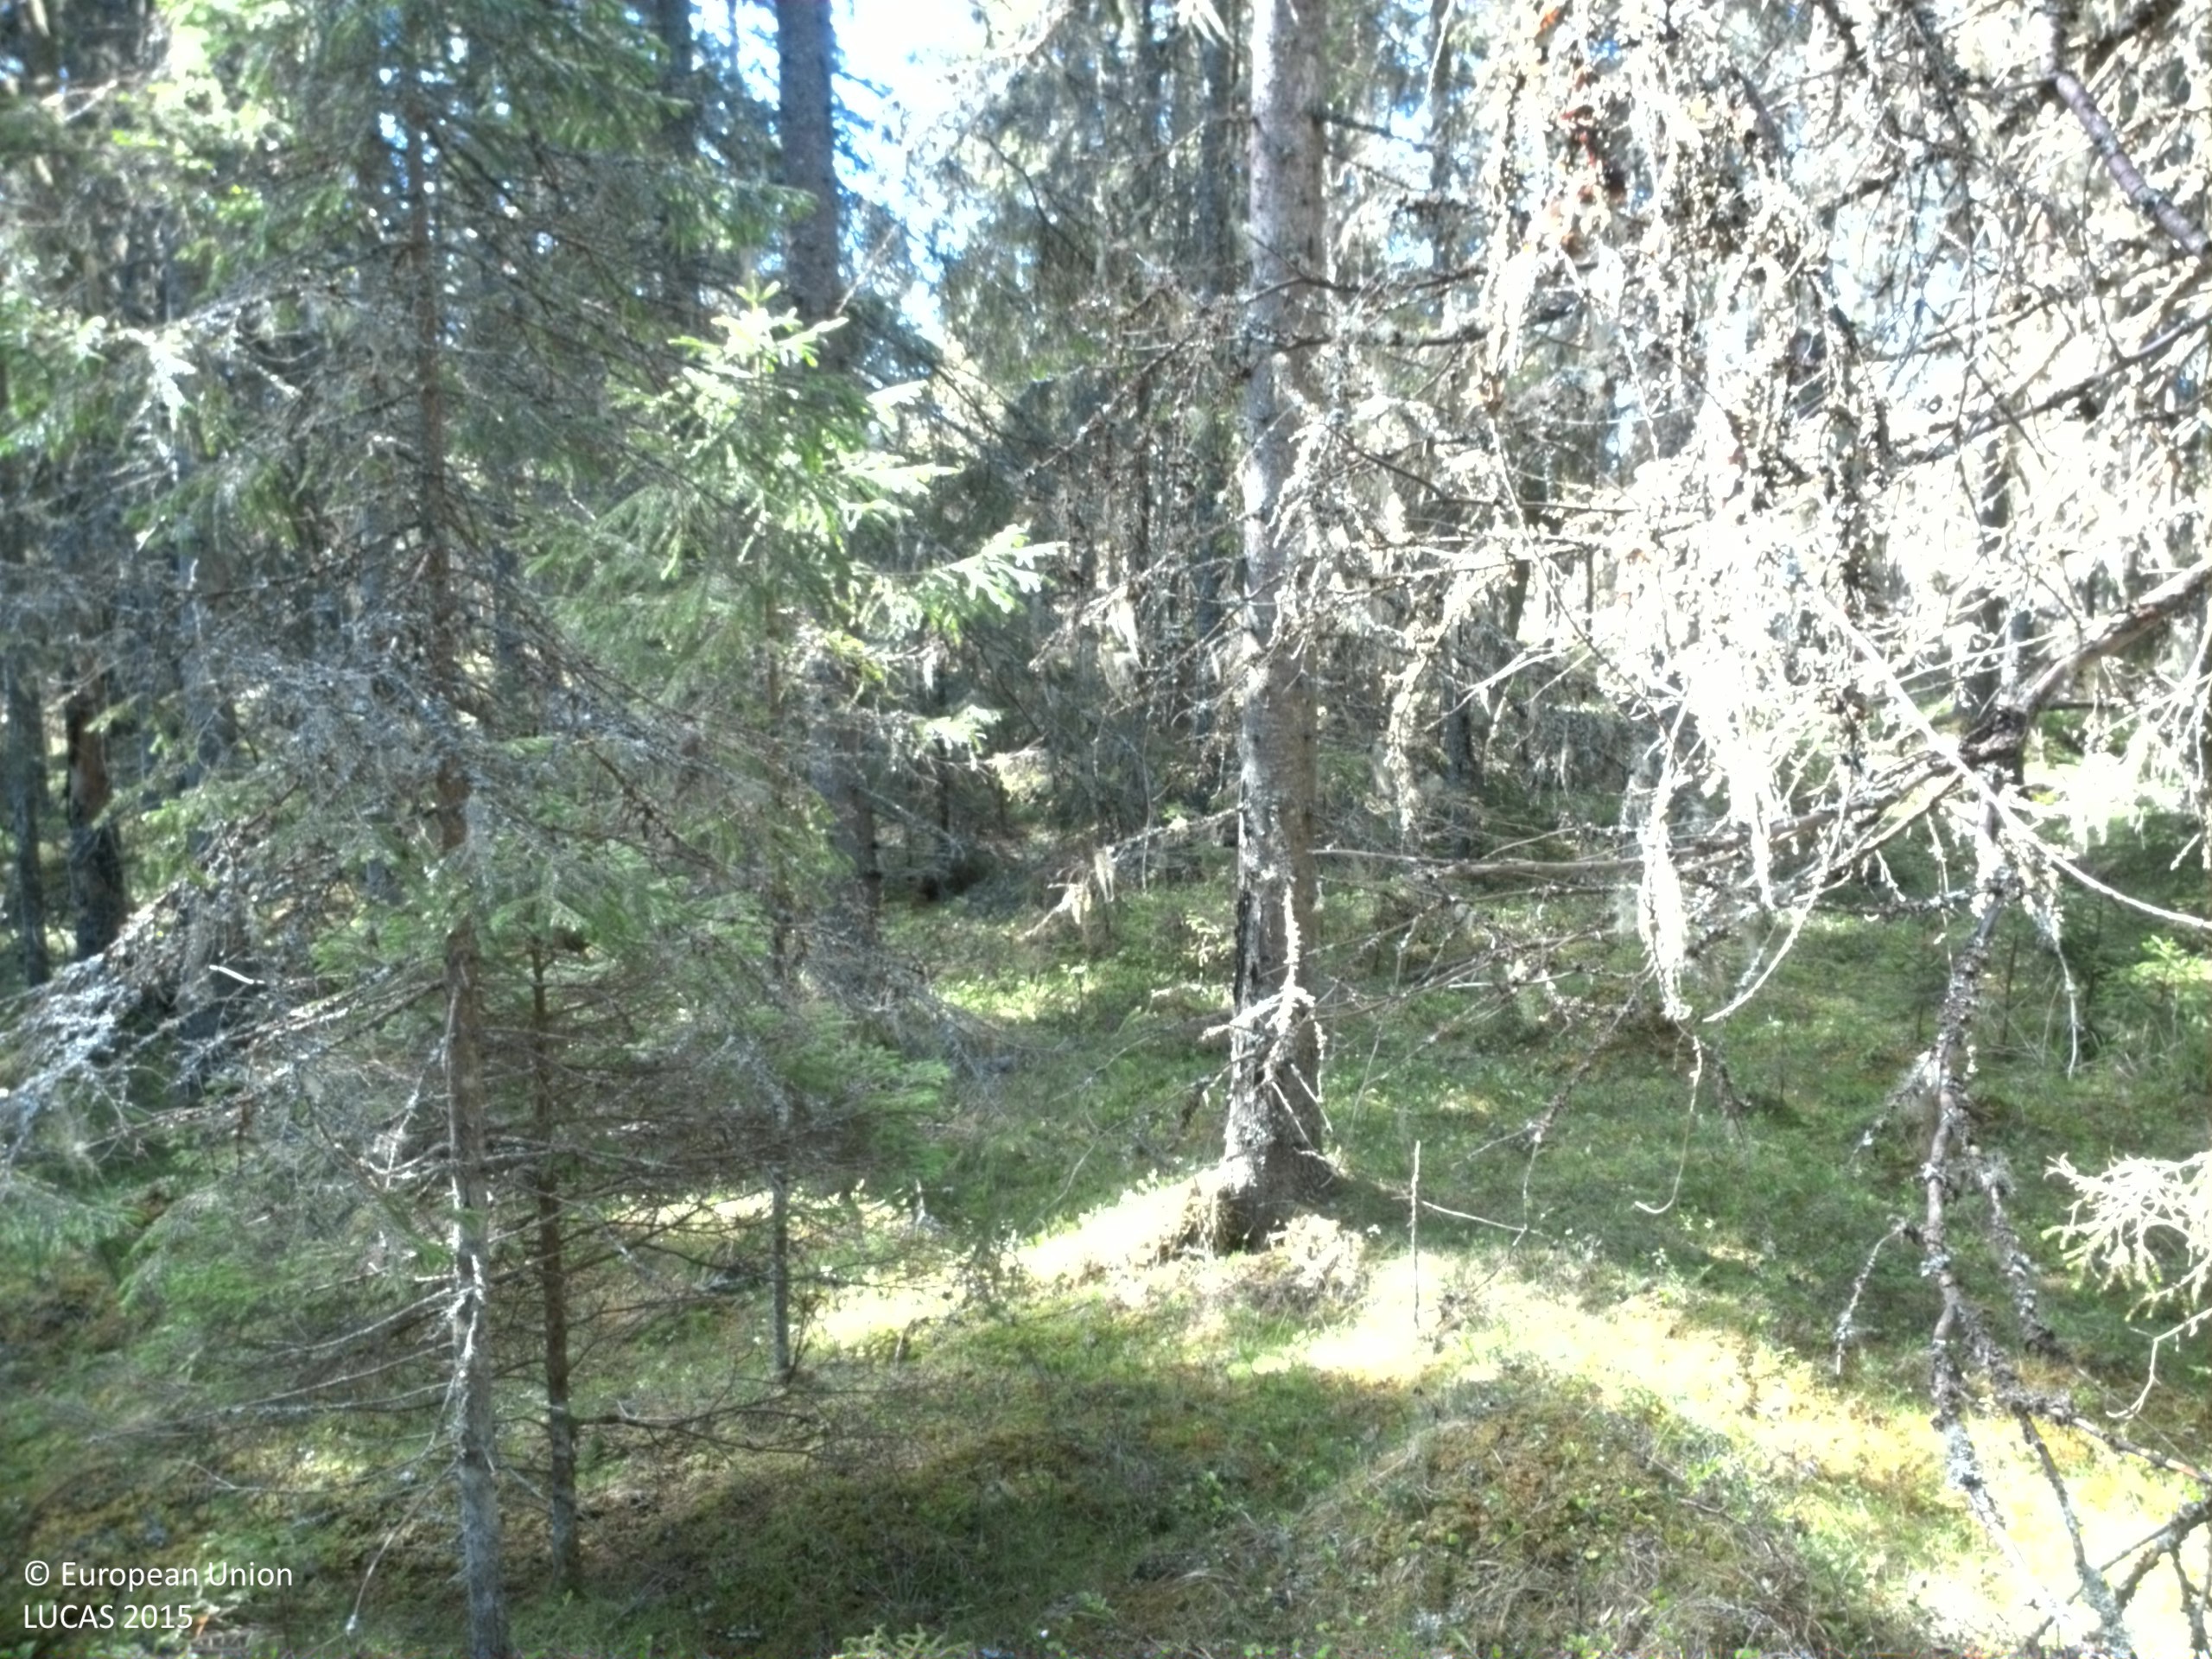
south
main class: Woodland
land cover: Spruce dominated coniferous woodland
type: boreal forest
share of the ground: > 75 %
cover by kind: coniferous forest trees 85 %, shrubs 15 %
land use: Forestry
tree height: > 5 m
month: May
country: SE
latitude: 62.8219
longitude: 18.2417
